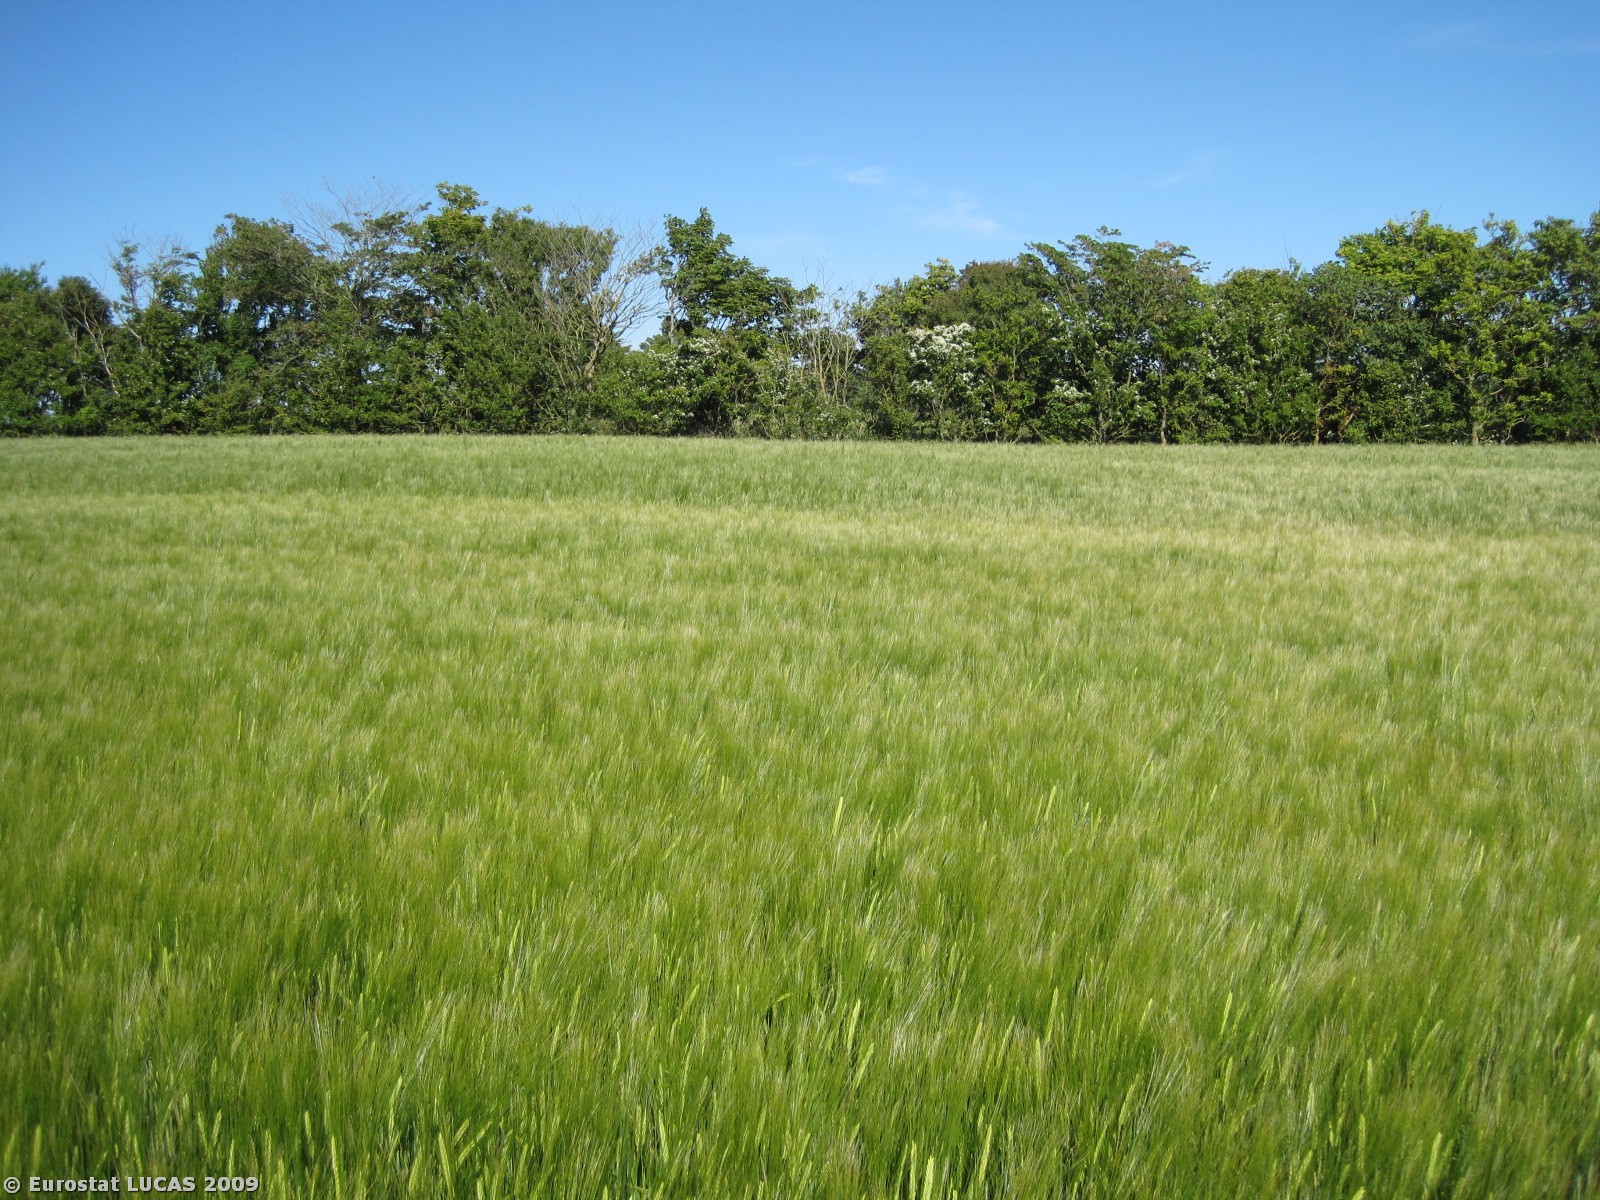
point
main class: Cropland
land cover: Barley
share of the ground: > 75 %
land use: Agriculture (excluding fallow land and kitchen gardens)
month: June
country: DK
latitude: 57.5181
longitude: 10.0167
